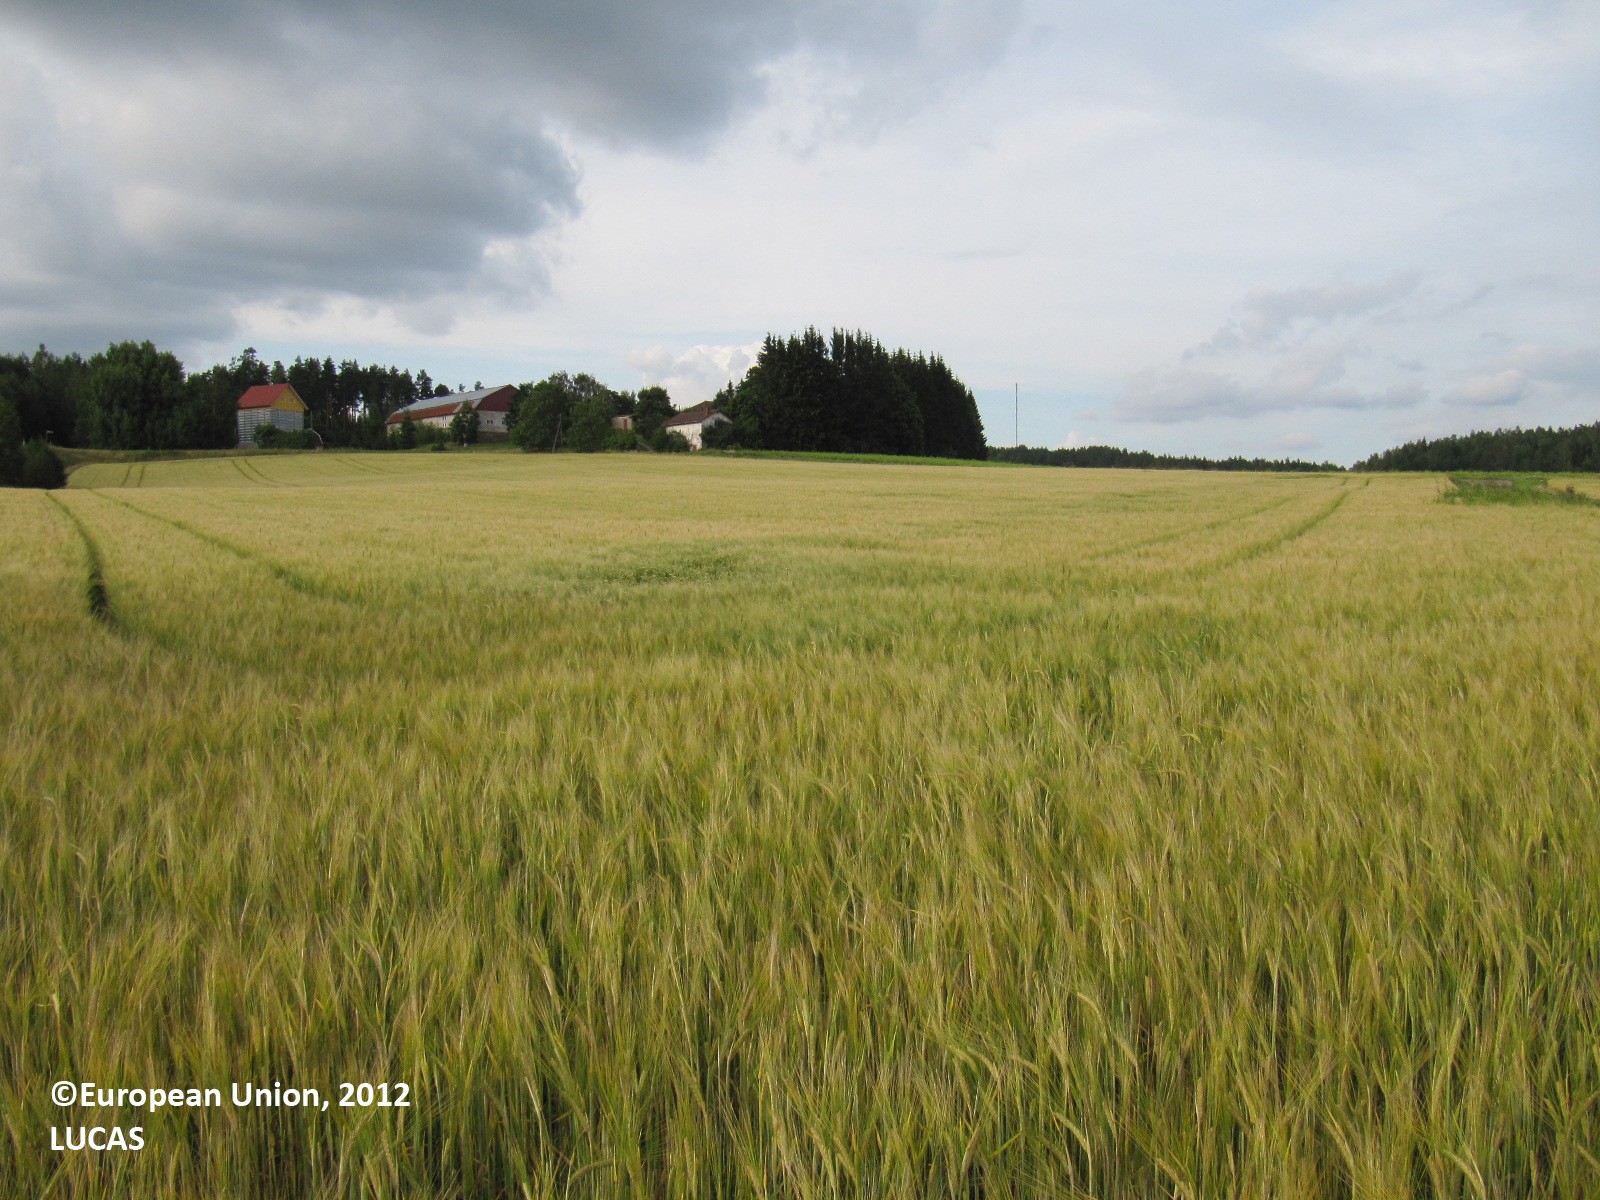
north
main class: Cropland
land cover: Barley
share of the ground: > 75 %
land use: Agriculture (excluding fallow land and kitchen gardens)
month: August
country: FI
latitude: 60.3163
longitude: 23.0971
